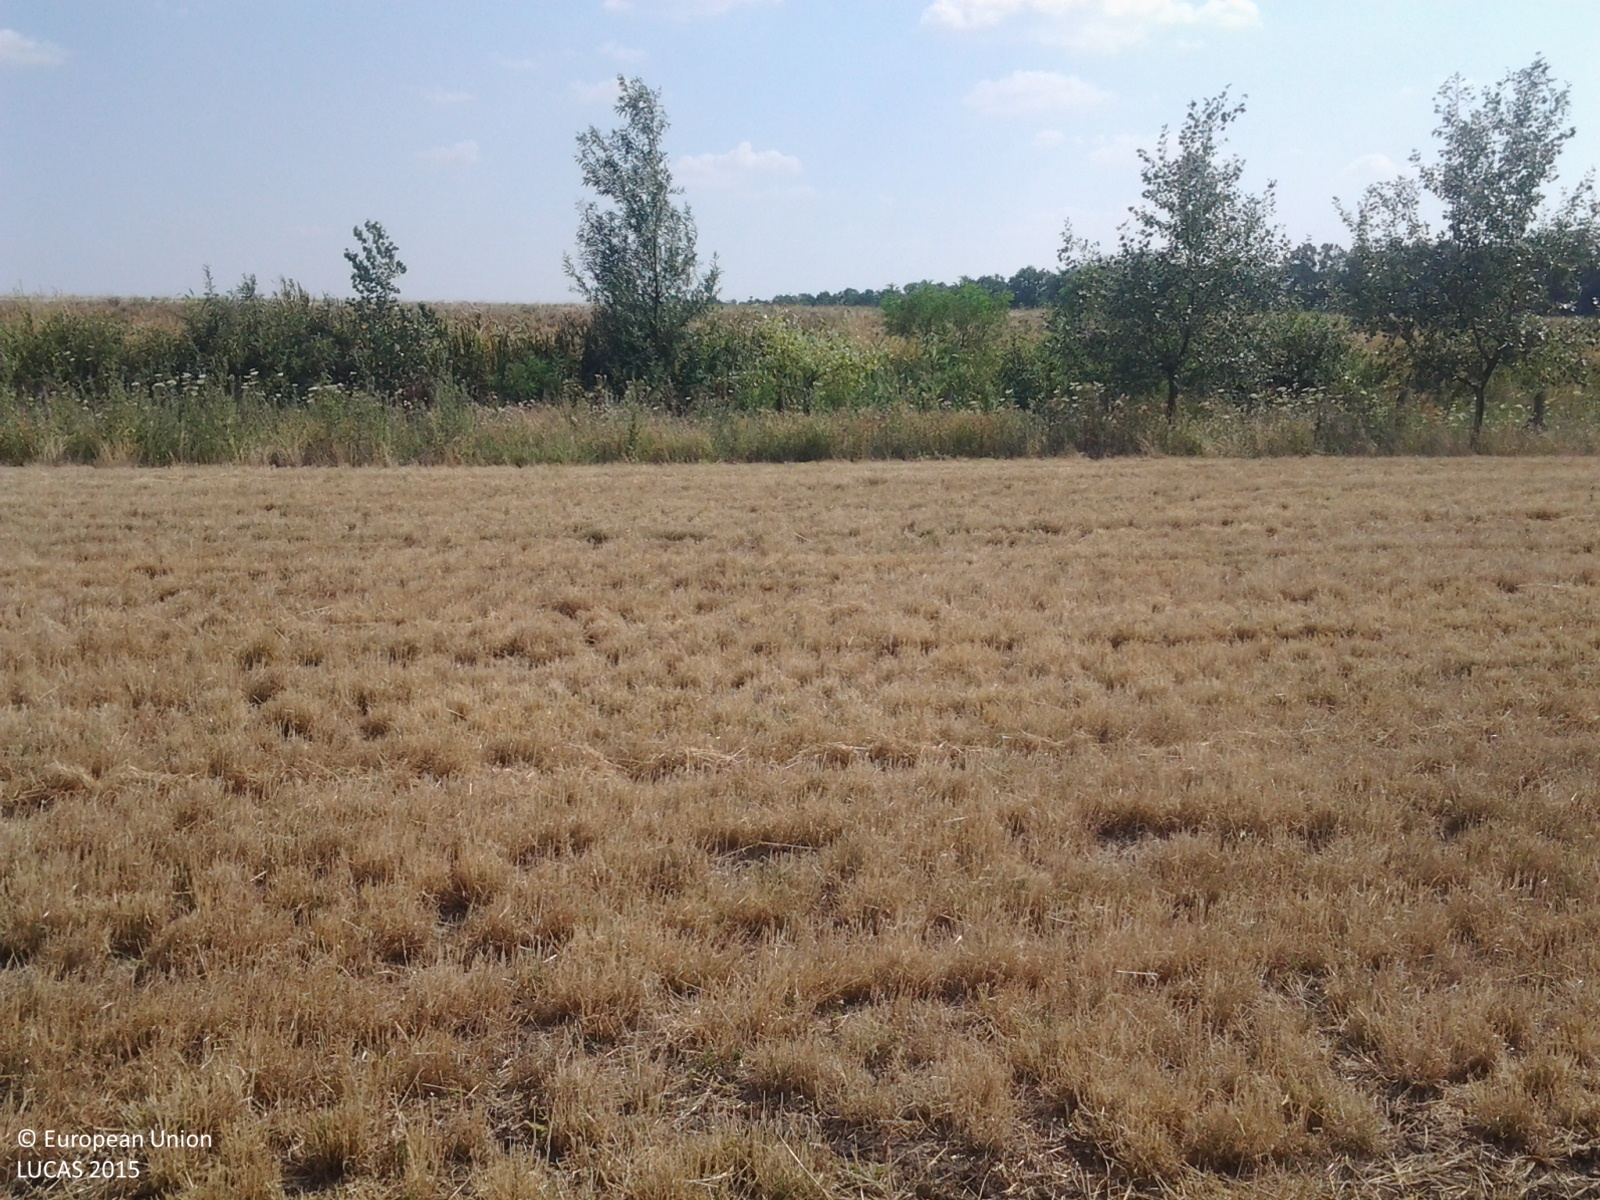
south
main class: Cropland
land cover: Common wheat
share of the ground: < 10 %
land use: Agriculture (excluding fallow land and kitchen gardens)
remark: Harvested field
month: July
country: HU
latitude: 47.2454
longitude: 20.7205
